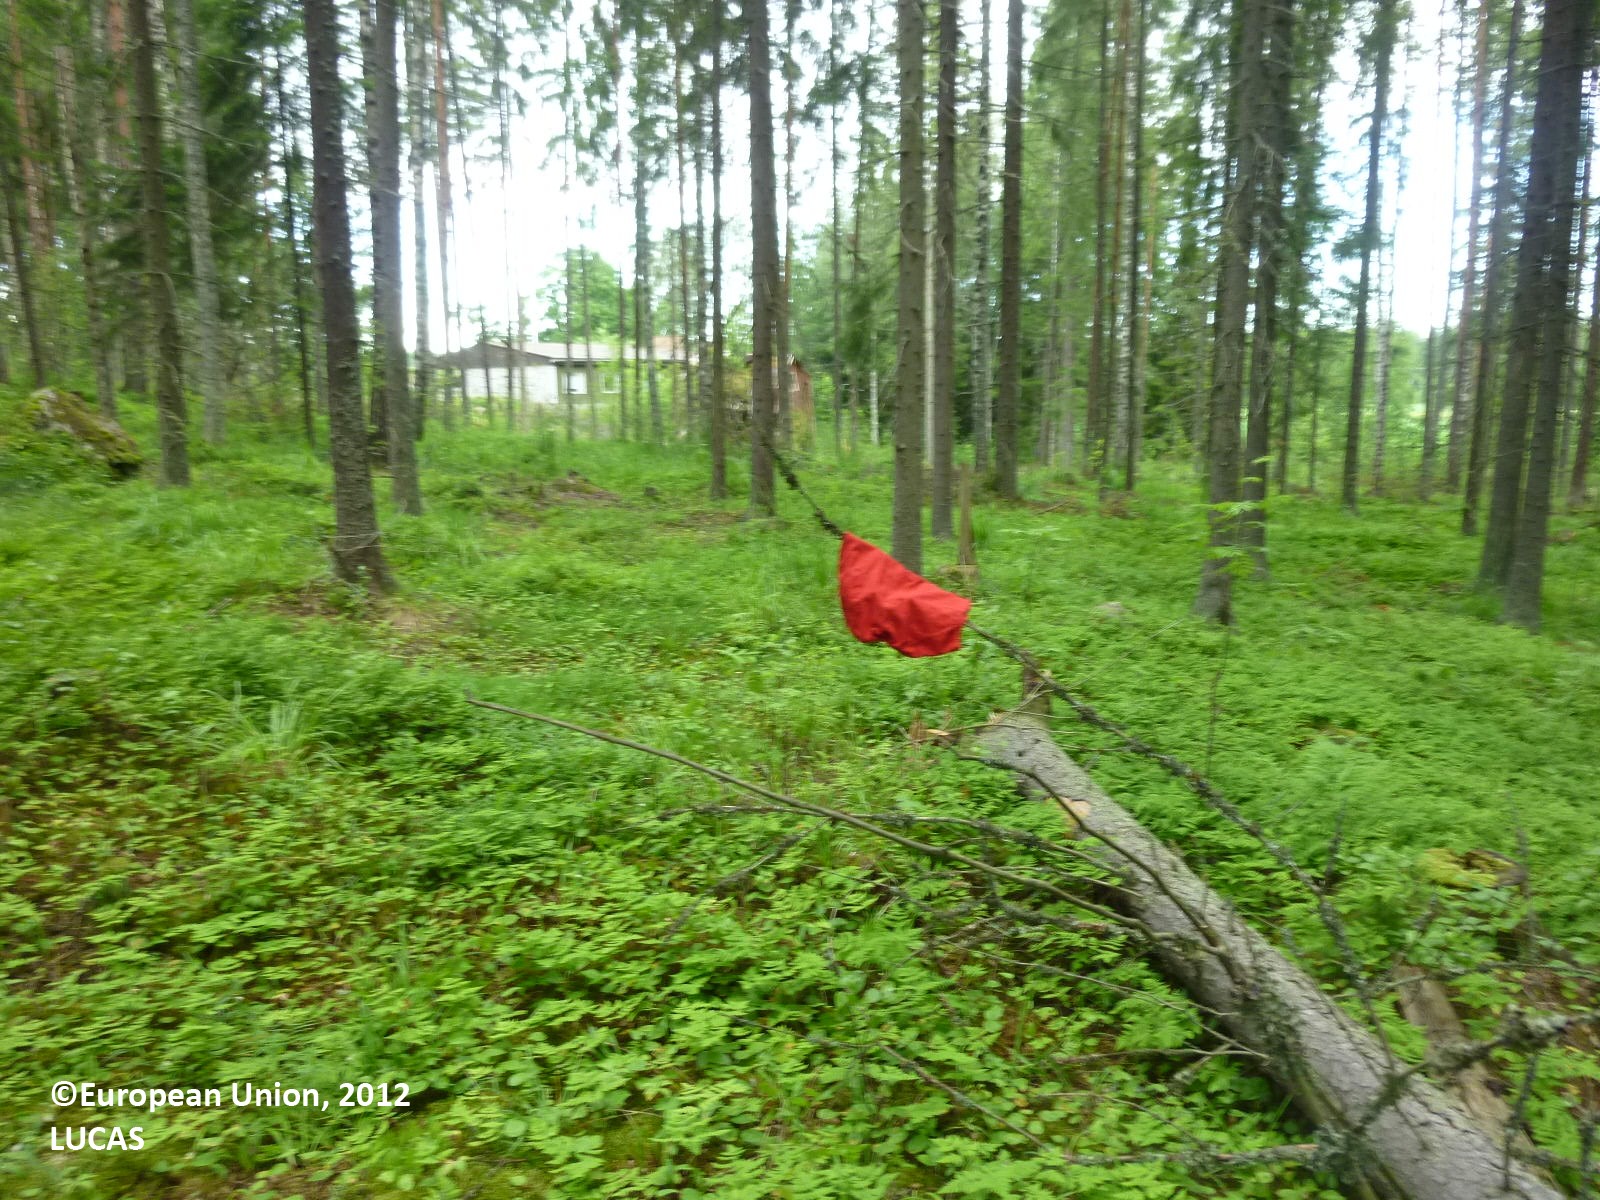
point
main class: Woodland
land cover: Spruce dominated coniferous woodland
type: boreal forest
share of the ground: > 75 %
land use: Forestry
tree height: > 5 m
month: July
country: FI
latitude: 61.3064
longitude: 22.0263
